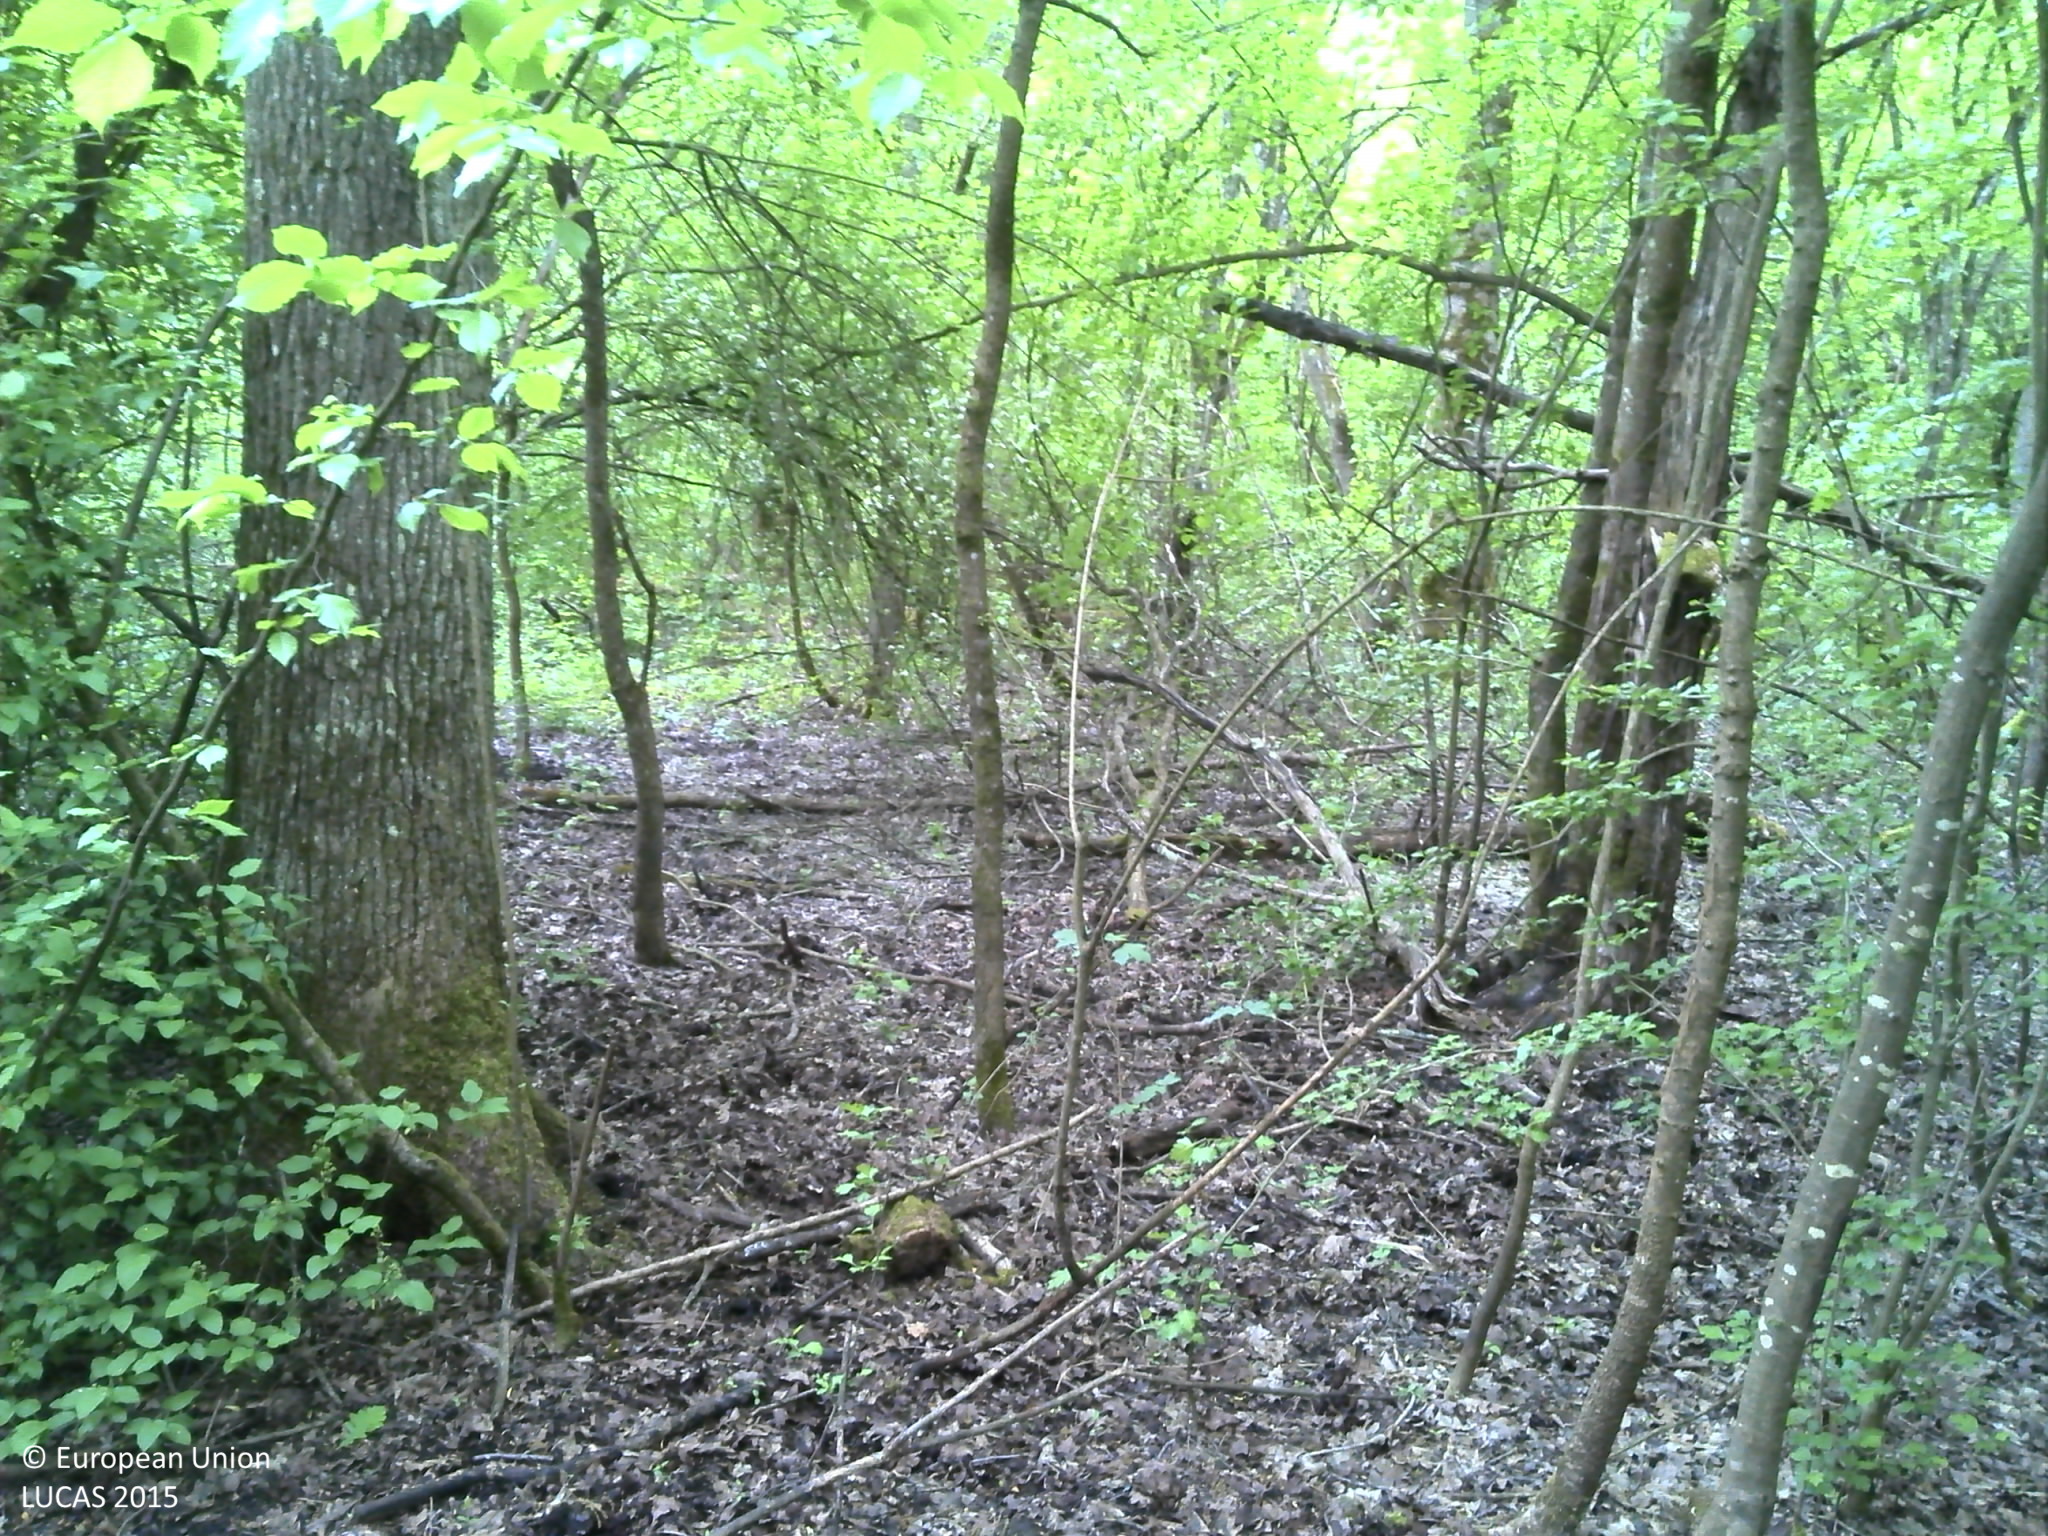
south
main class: Woodland
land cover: Broadleaved woodland
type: mesophytic deciduous forest
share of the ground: > 75 %
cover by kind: broadleaved forest trees 100 %
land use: Forestry
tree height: > 5 m
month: April
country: HR
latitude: 45.0304
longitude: 18.9808
